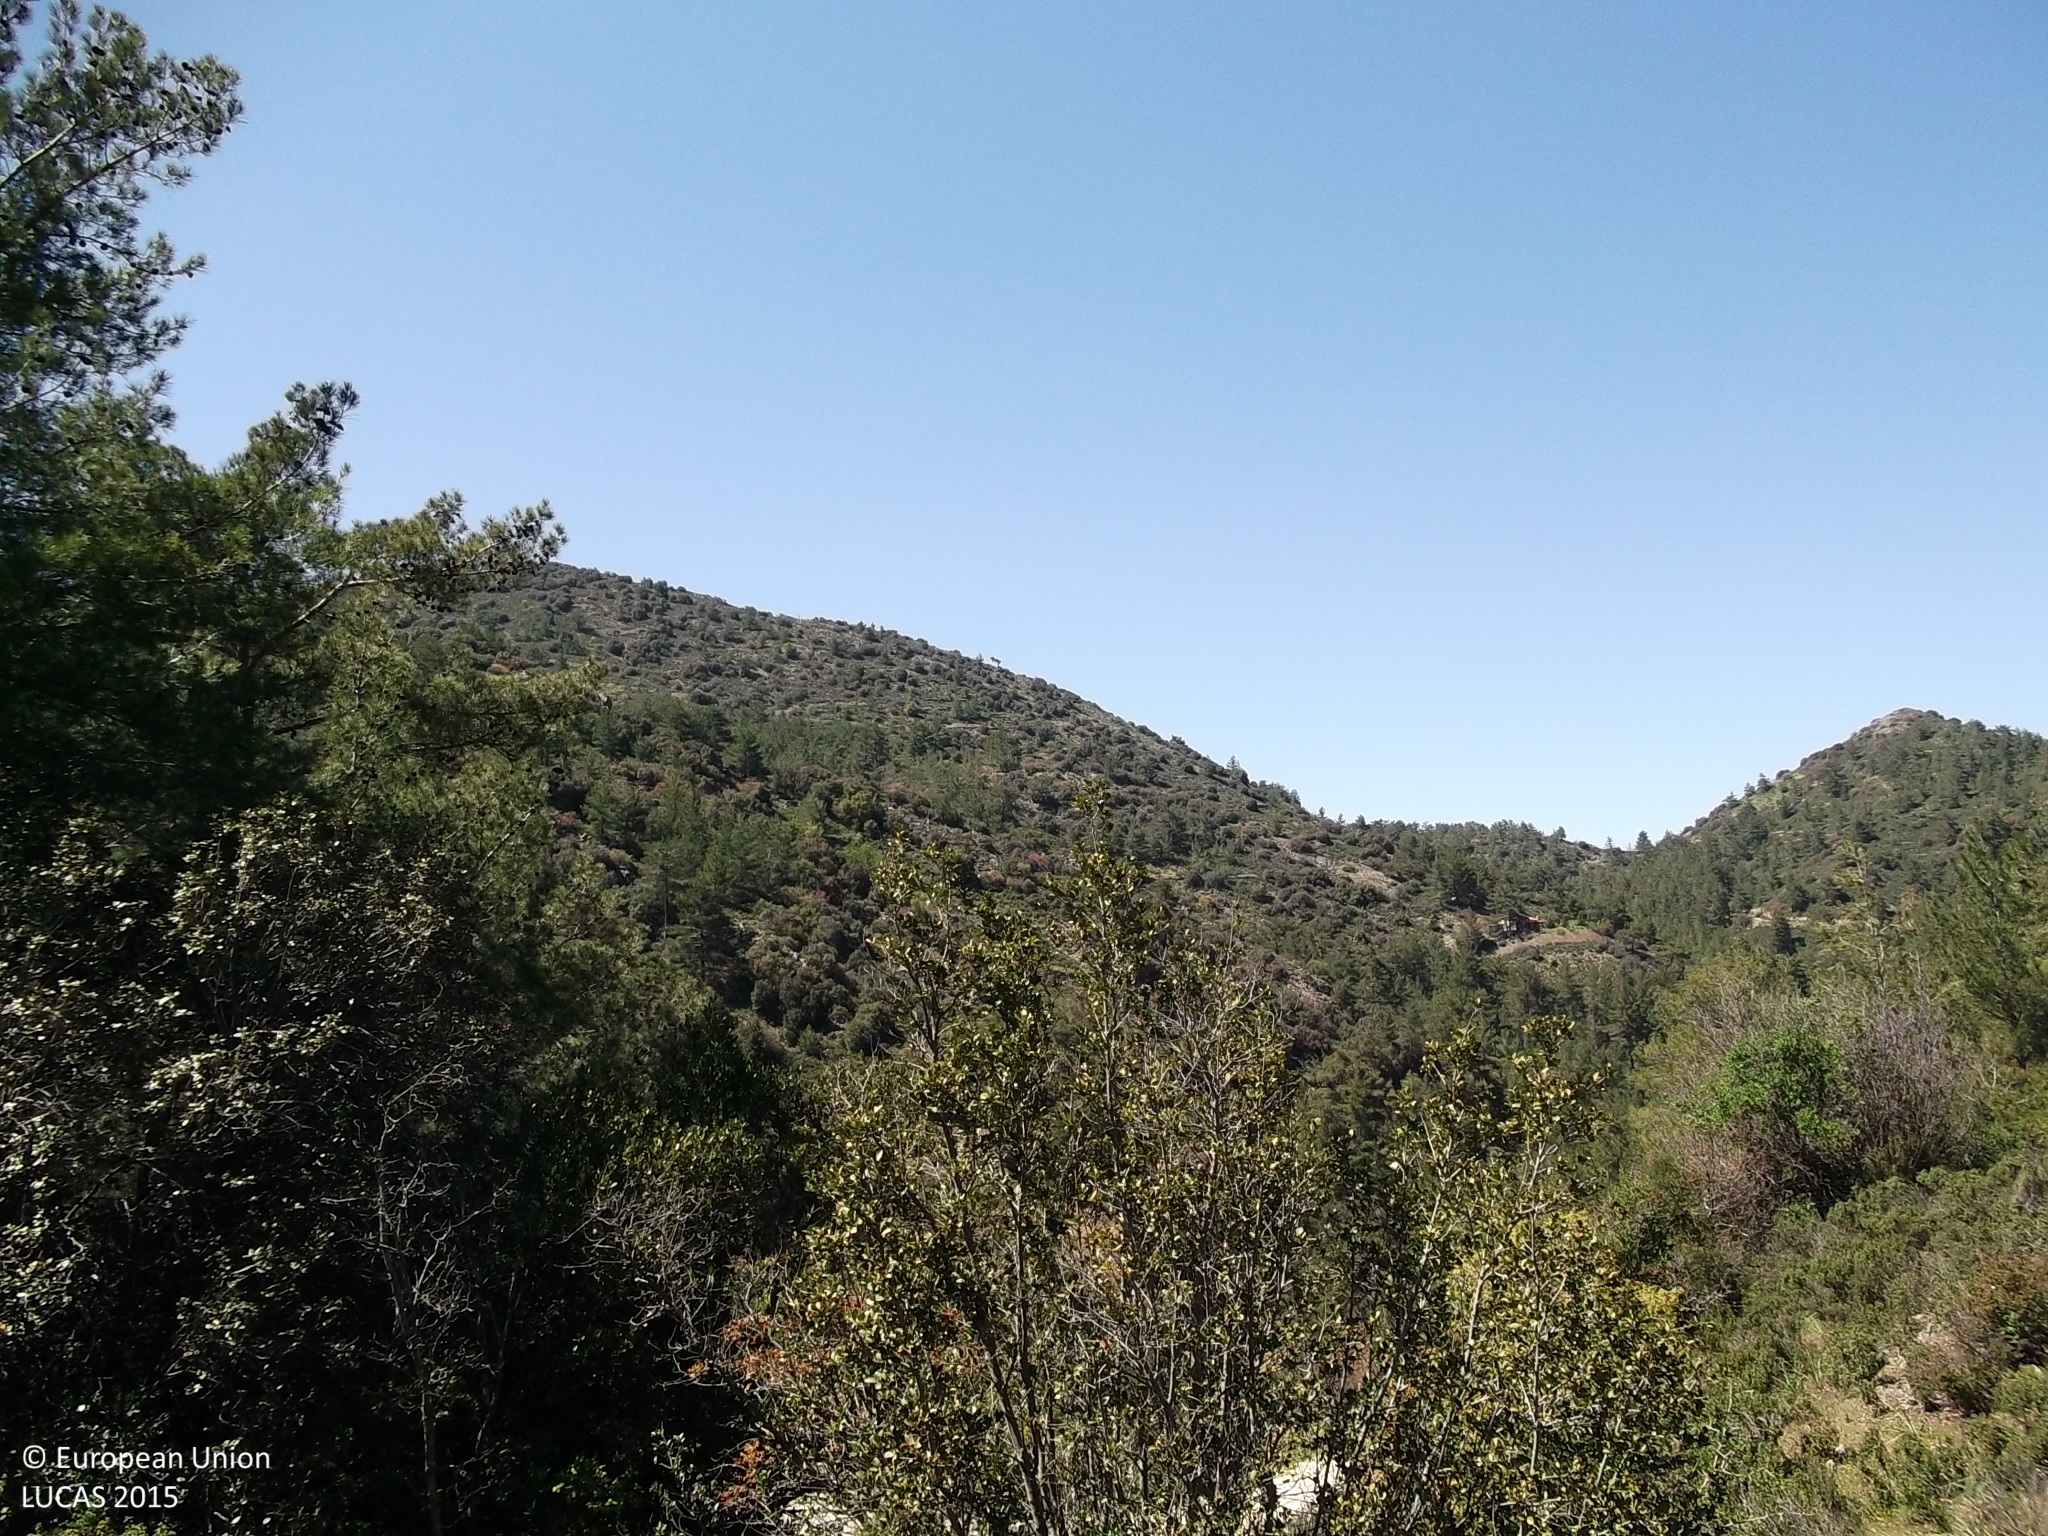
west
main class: Shrubland
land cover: Shrubland with sparse tree cover
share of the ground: > 75 %
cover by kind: shrubs 75 %, consolidated bare surface 10 %, unconsolidated bare surface 10 %, coniferous forest trees 5 %
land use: Semi-natural and natural areas not in use
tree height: > 5 m
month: April
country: CY
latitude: 34.9178
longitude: 33.1752
